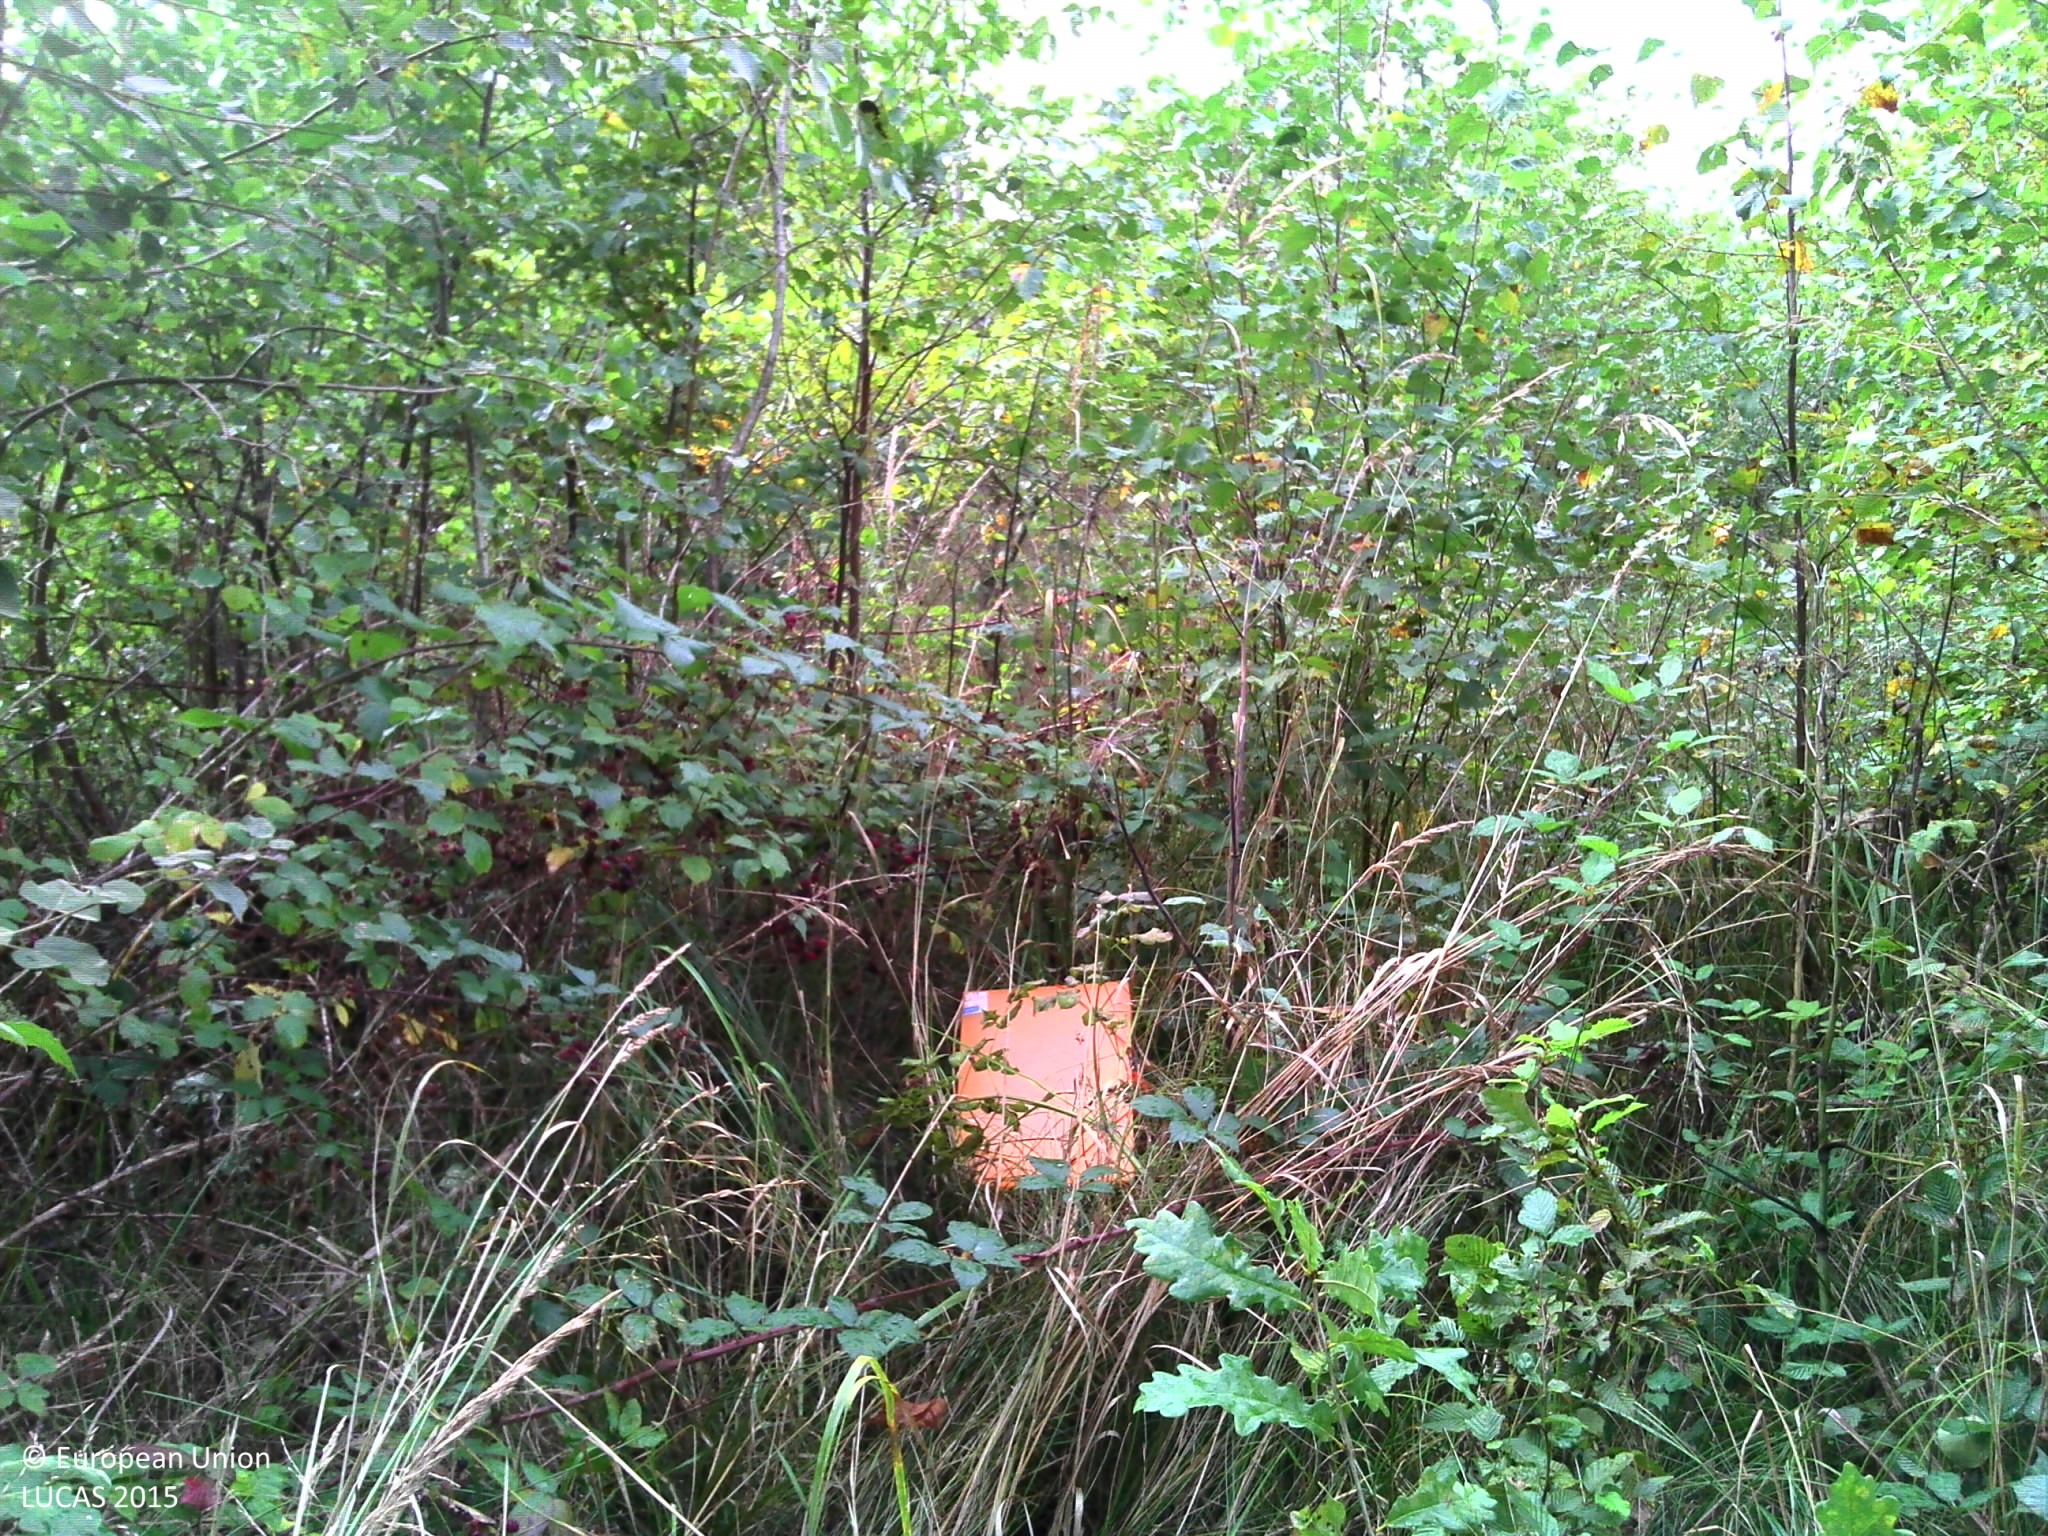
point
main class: Woodland
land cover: Broadleaved woodland
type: mesophytic deciduous forest
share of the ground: > 75 %
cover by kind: broadleaved forest trees 80 %, shrubs 10 %, herbaceous plants 10 %
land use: Forestry
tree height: > 5 m
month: September
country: FR
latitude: 47.1030
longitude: 5.0598
